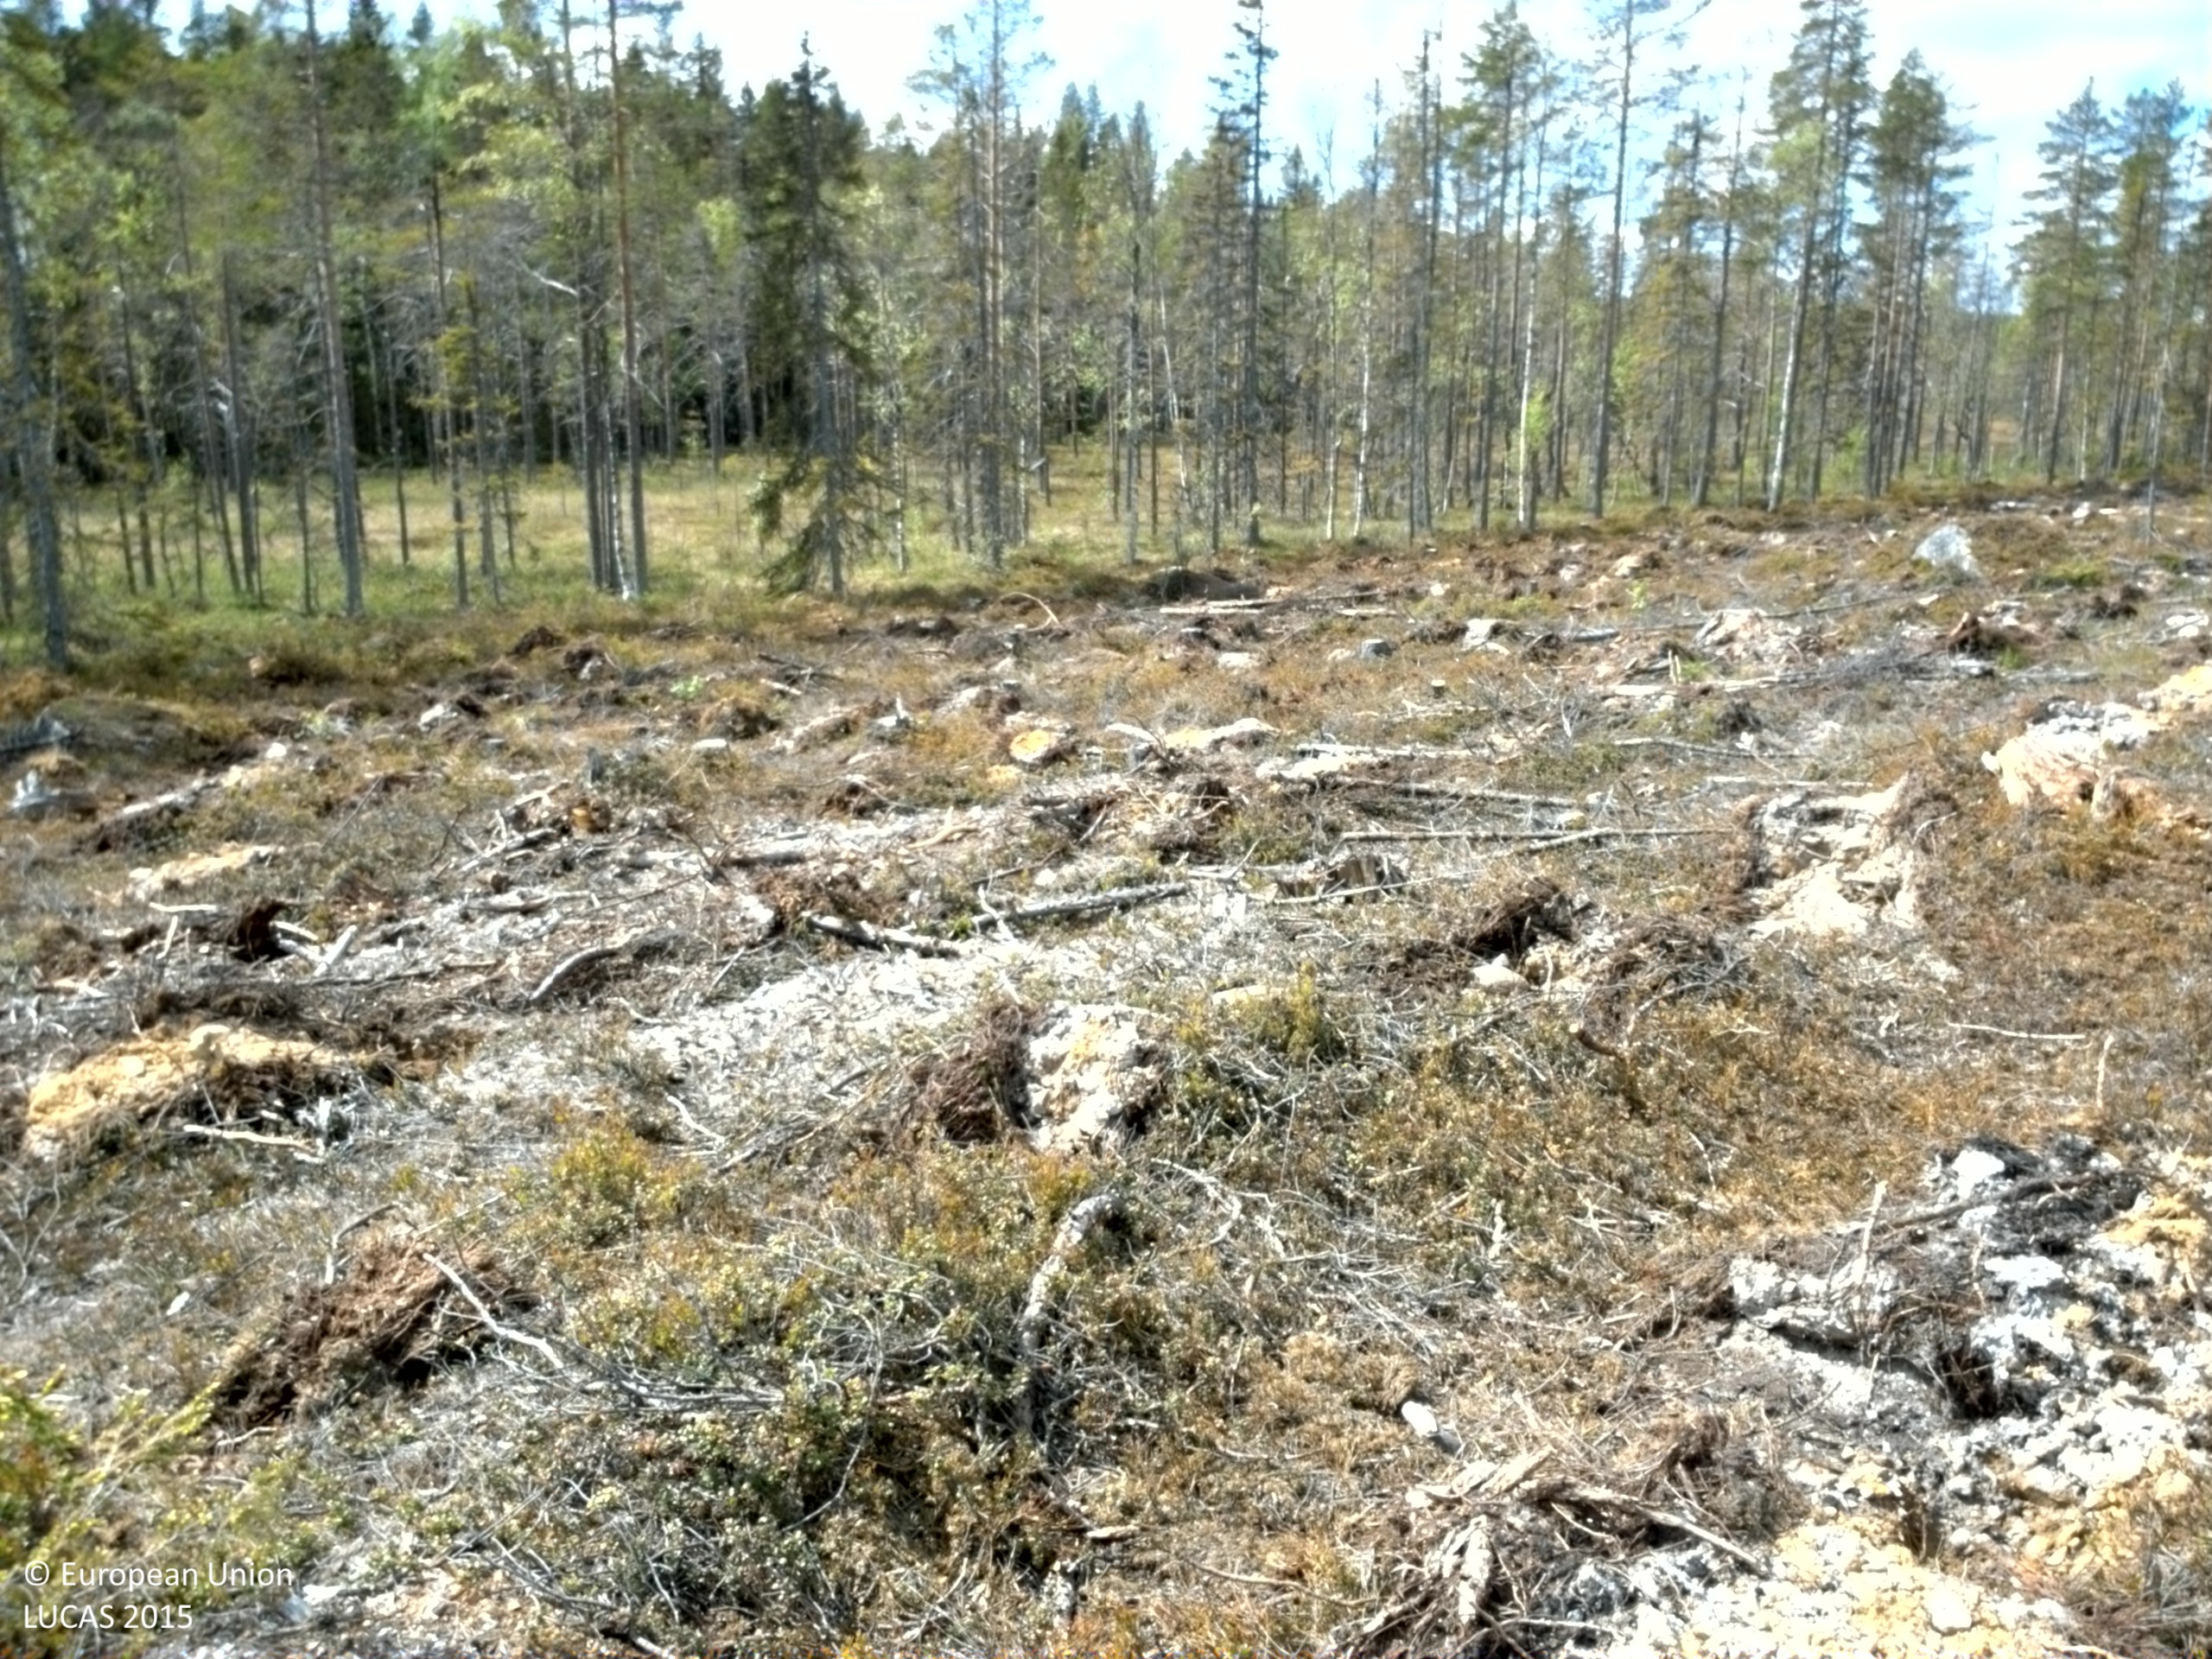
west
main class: Shrubland
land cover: Shrubland without tree cover
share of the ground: 50 - 75 %
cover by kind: shrubs 70 %, lichens and mosses 20 %, unconsolidated bare surface 10 %
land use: Forestry
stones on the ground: 25 - 50 %
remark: Clear cut
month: June
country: SE
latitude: 62.9954
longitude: 16.9450
